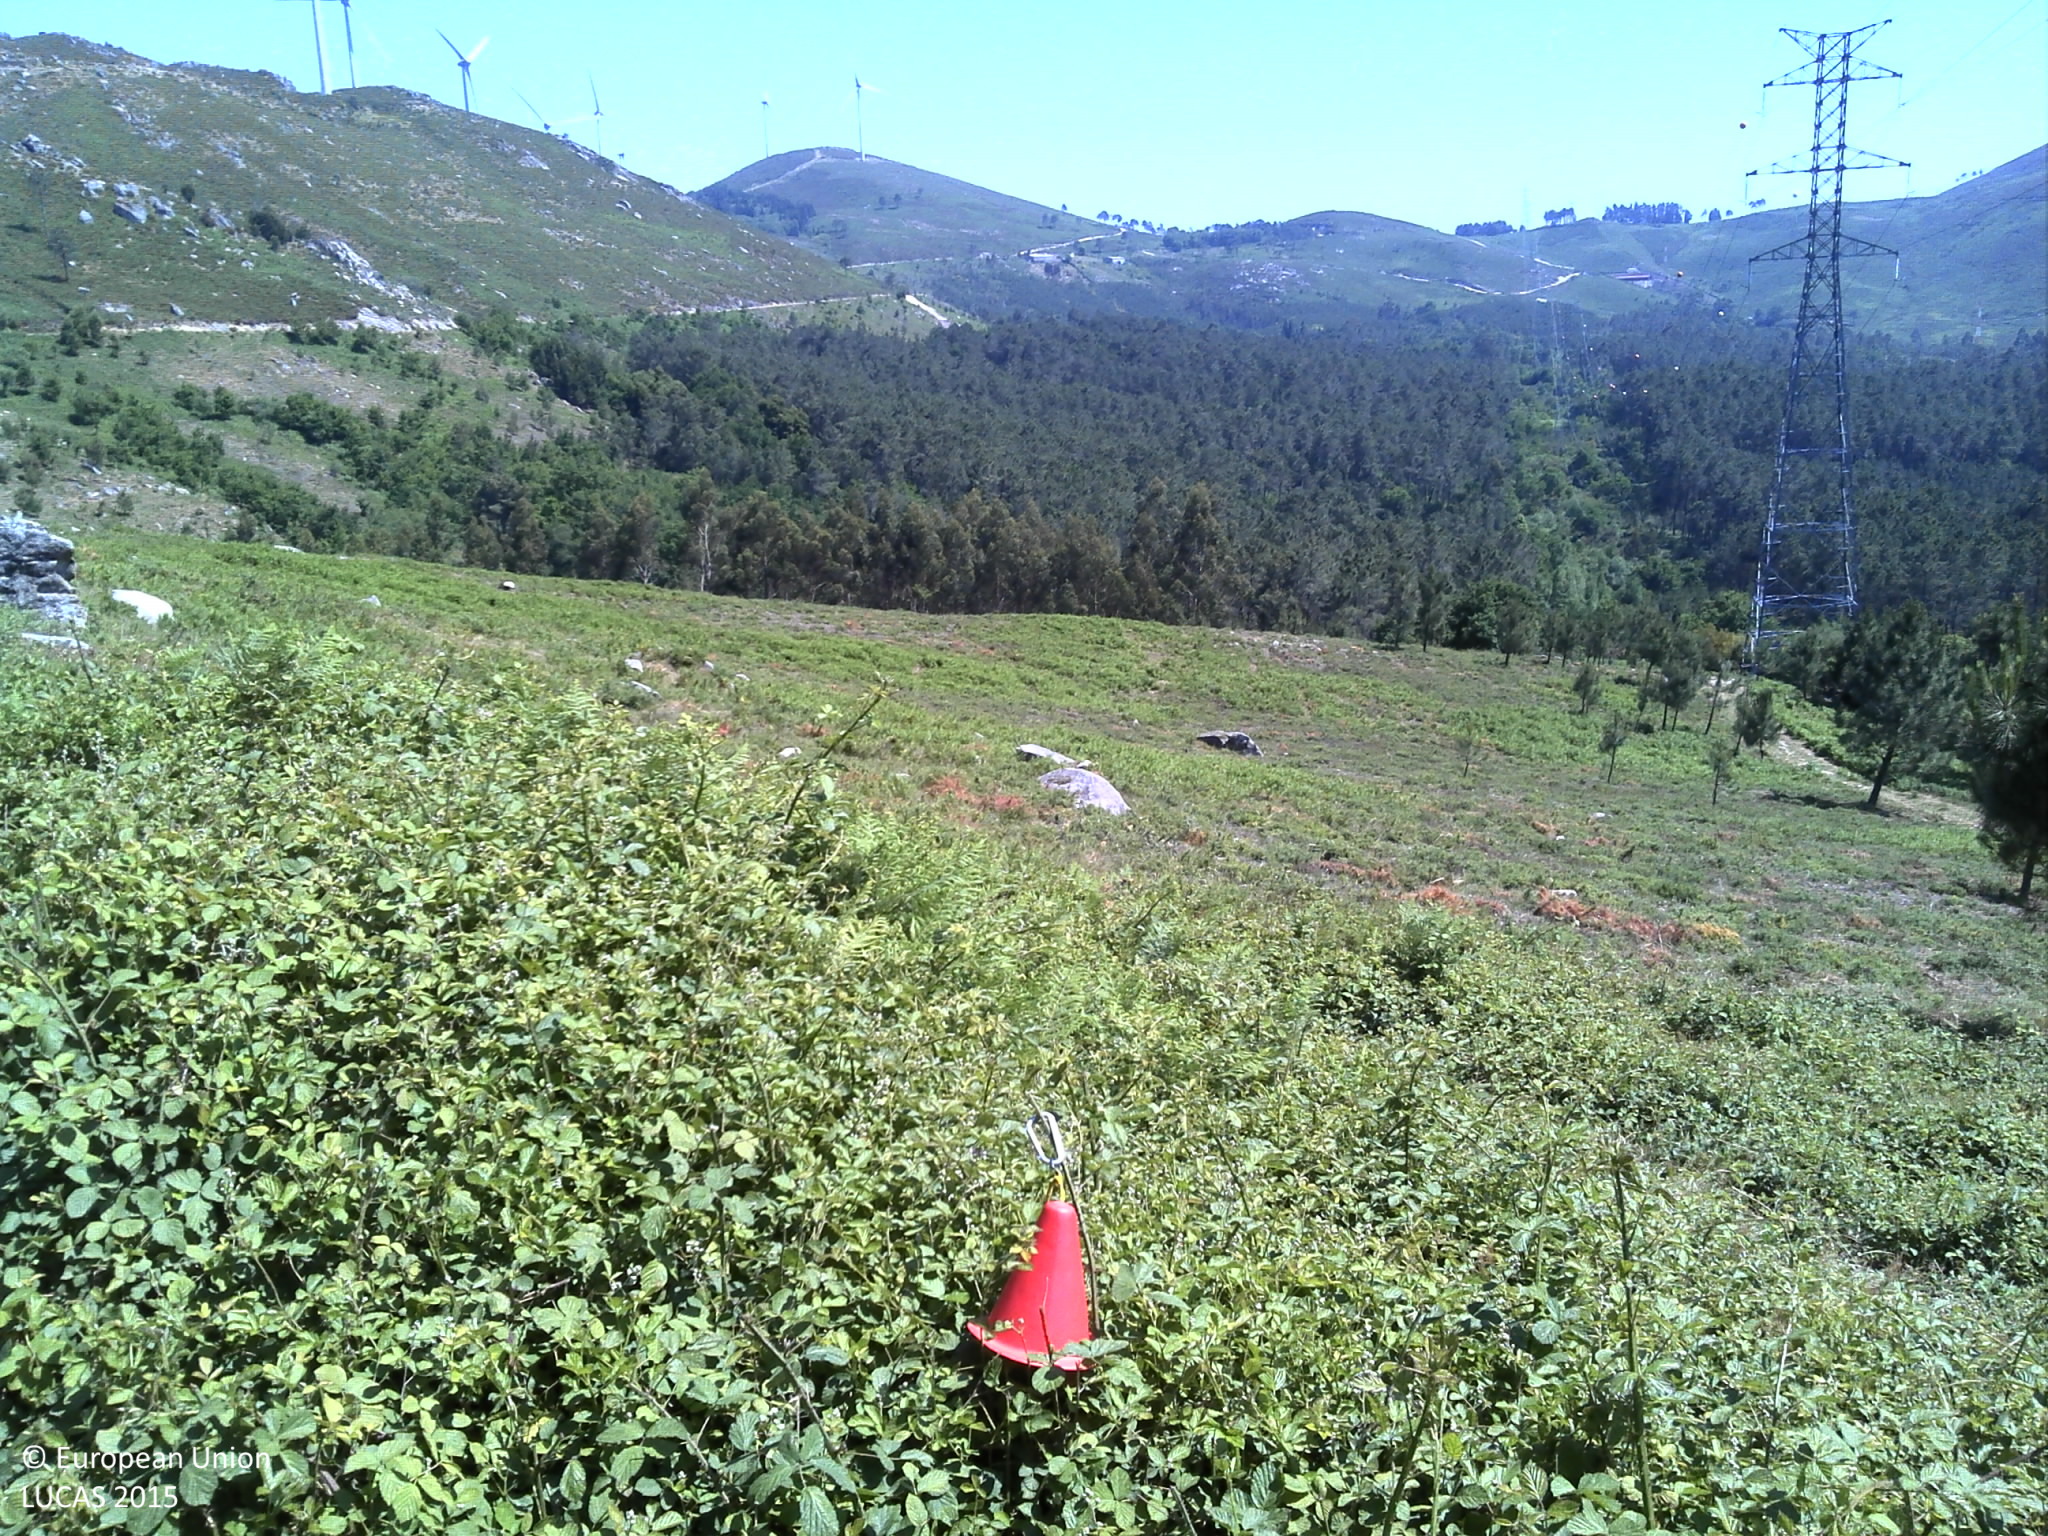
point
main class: Shrubland
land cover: Shrubland without tree cover
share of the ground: > 75 %
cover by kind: shrubs 80 %, herbaceous plants 10 %, unconsolidated bare surface 10 %
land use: Semi-natural and natural areas not in use
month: June
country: PT
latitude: 41.9991
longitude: -8.4270
